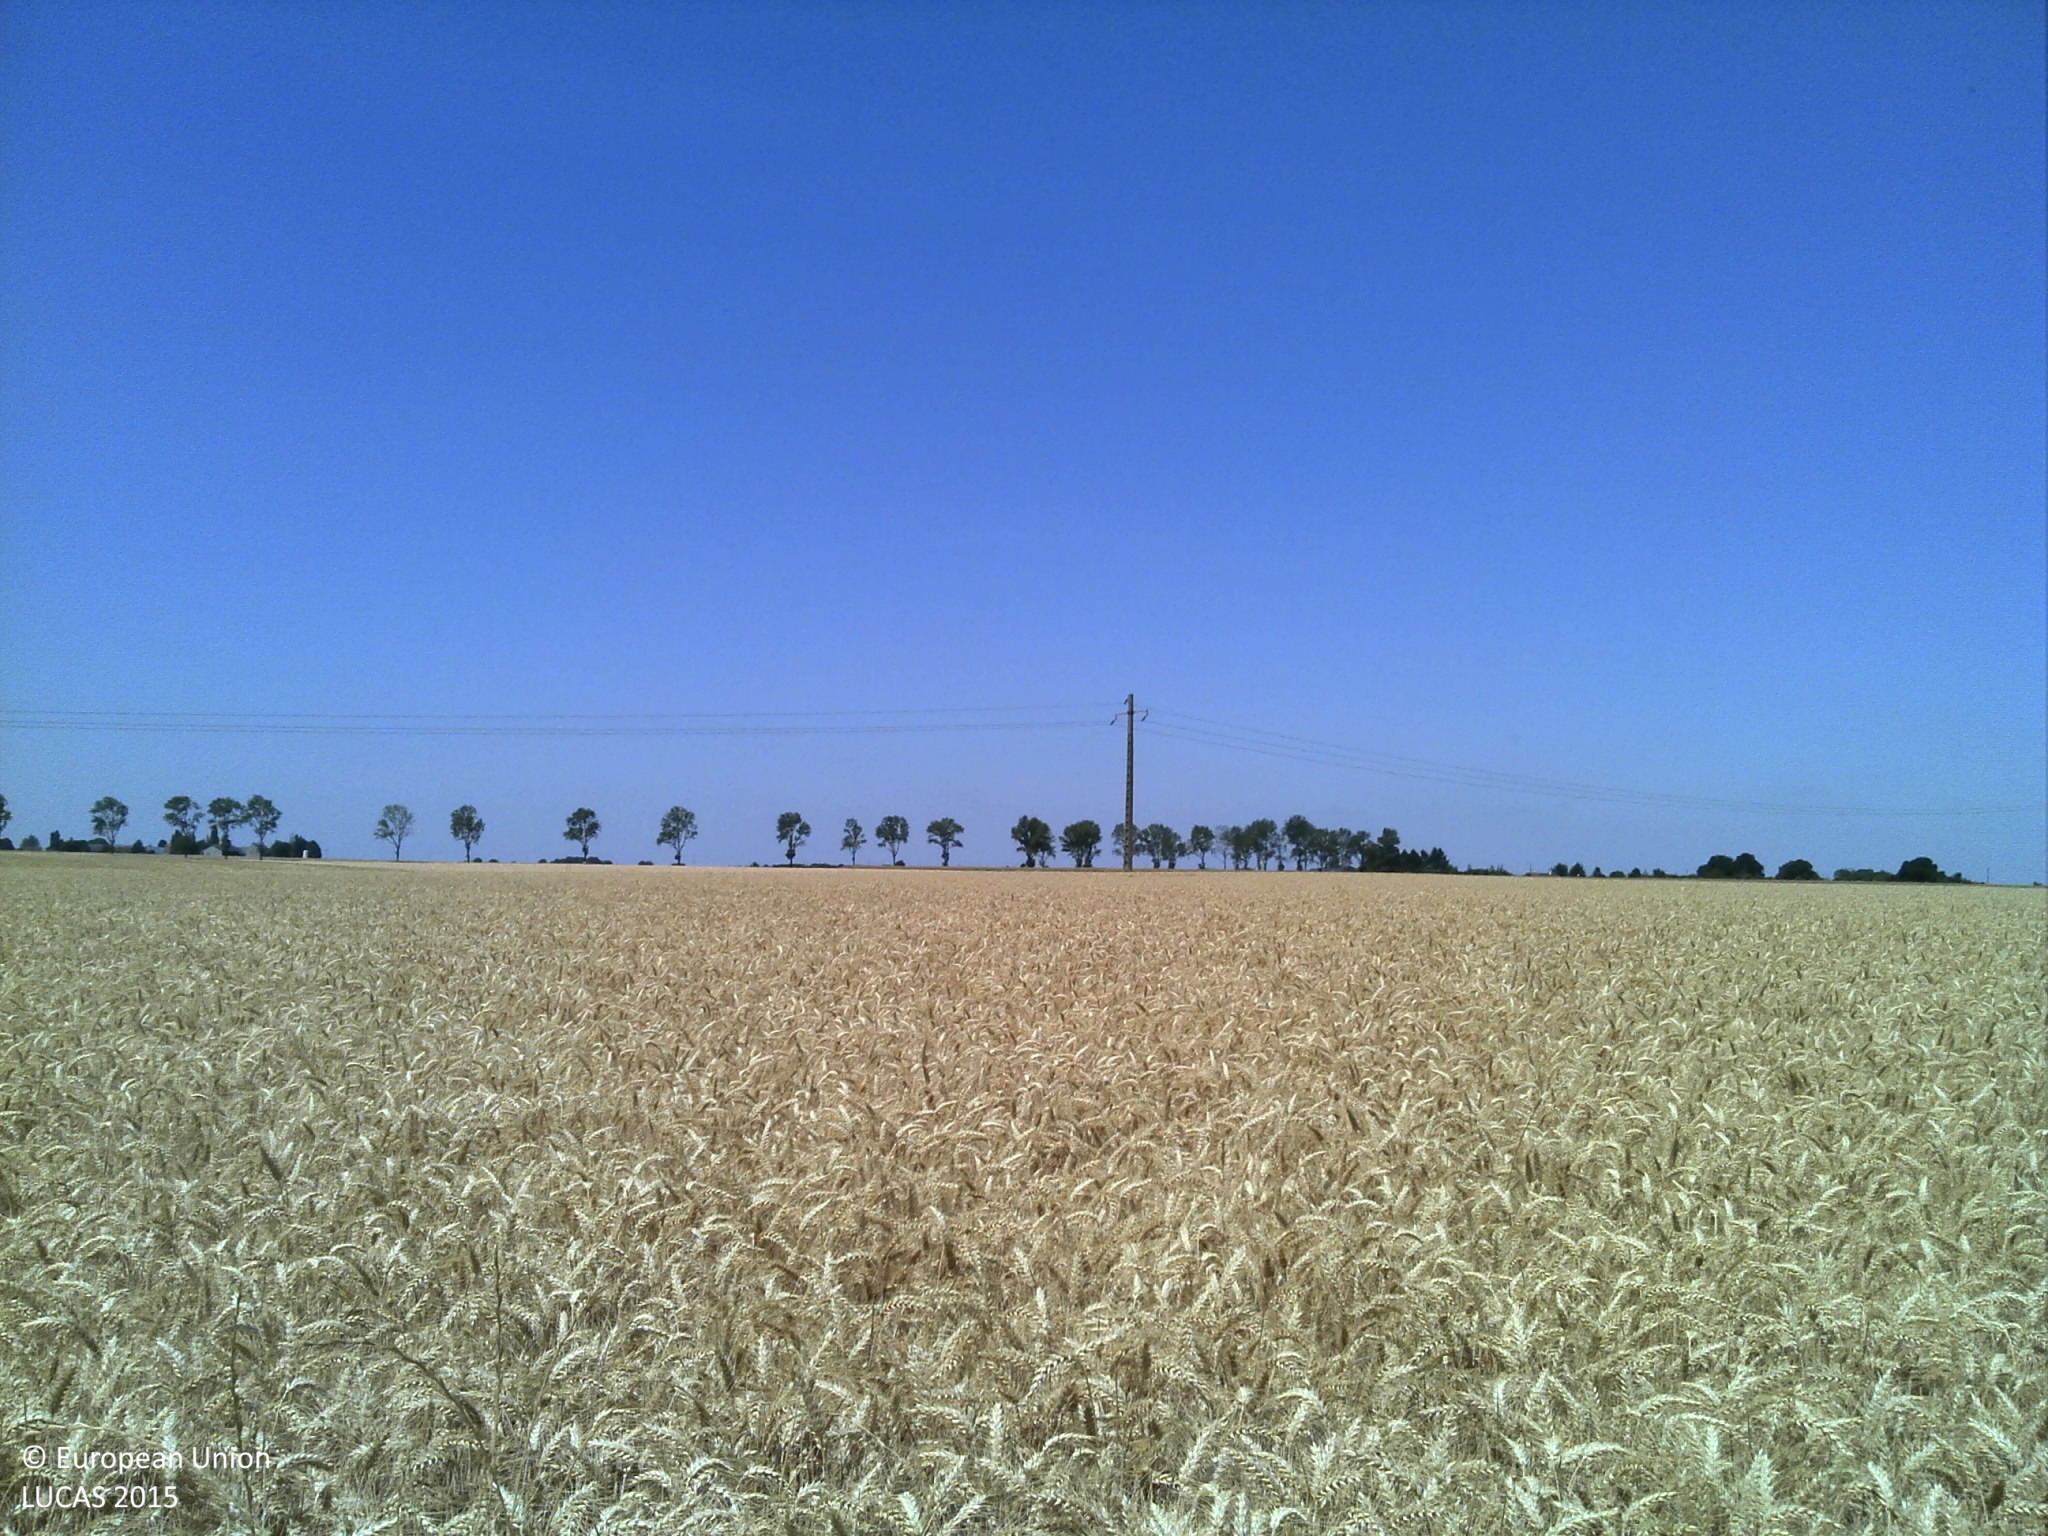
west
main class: Cropland
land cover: Durum wheat
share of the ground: > 75 %
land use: Agriculture (excluding fallow land and kitchen gardens)
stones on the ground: < 10 %
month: July
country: FR
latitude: 48.4188
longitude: 1.9738
